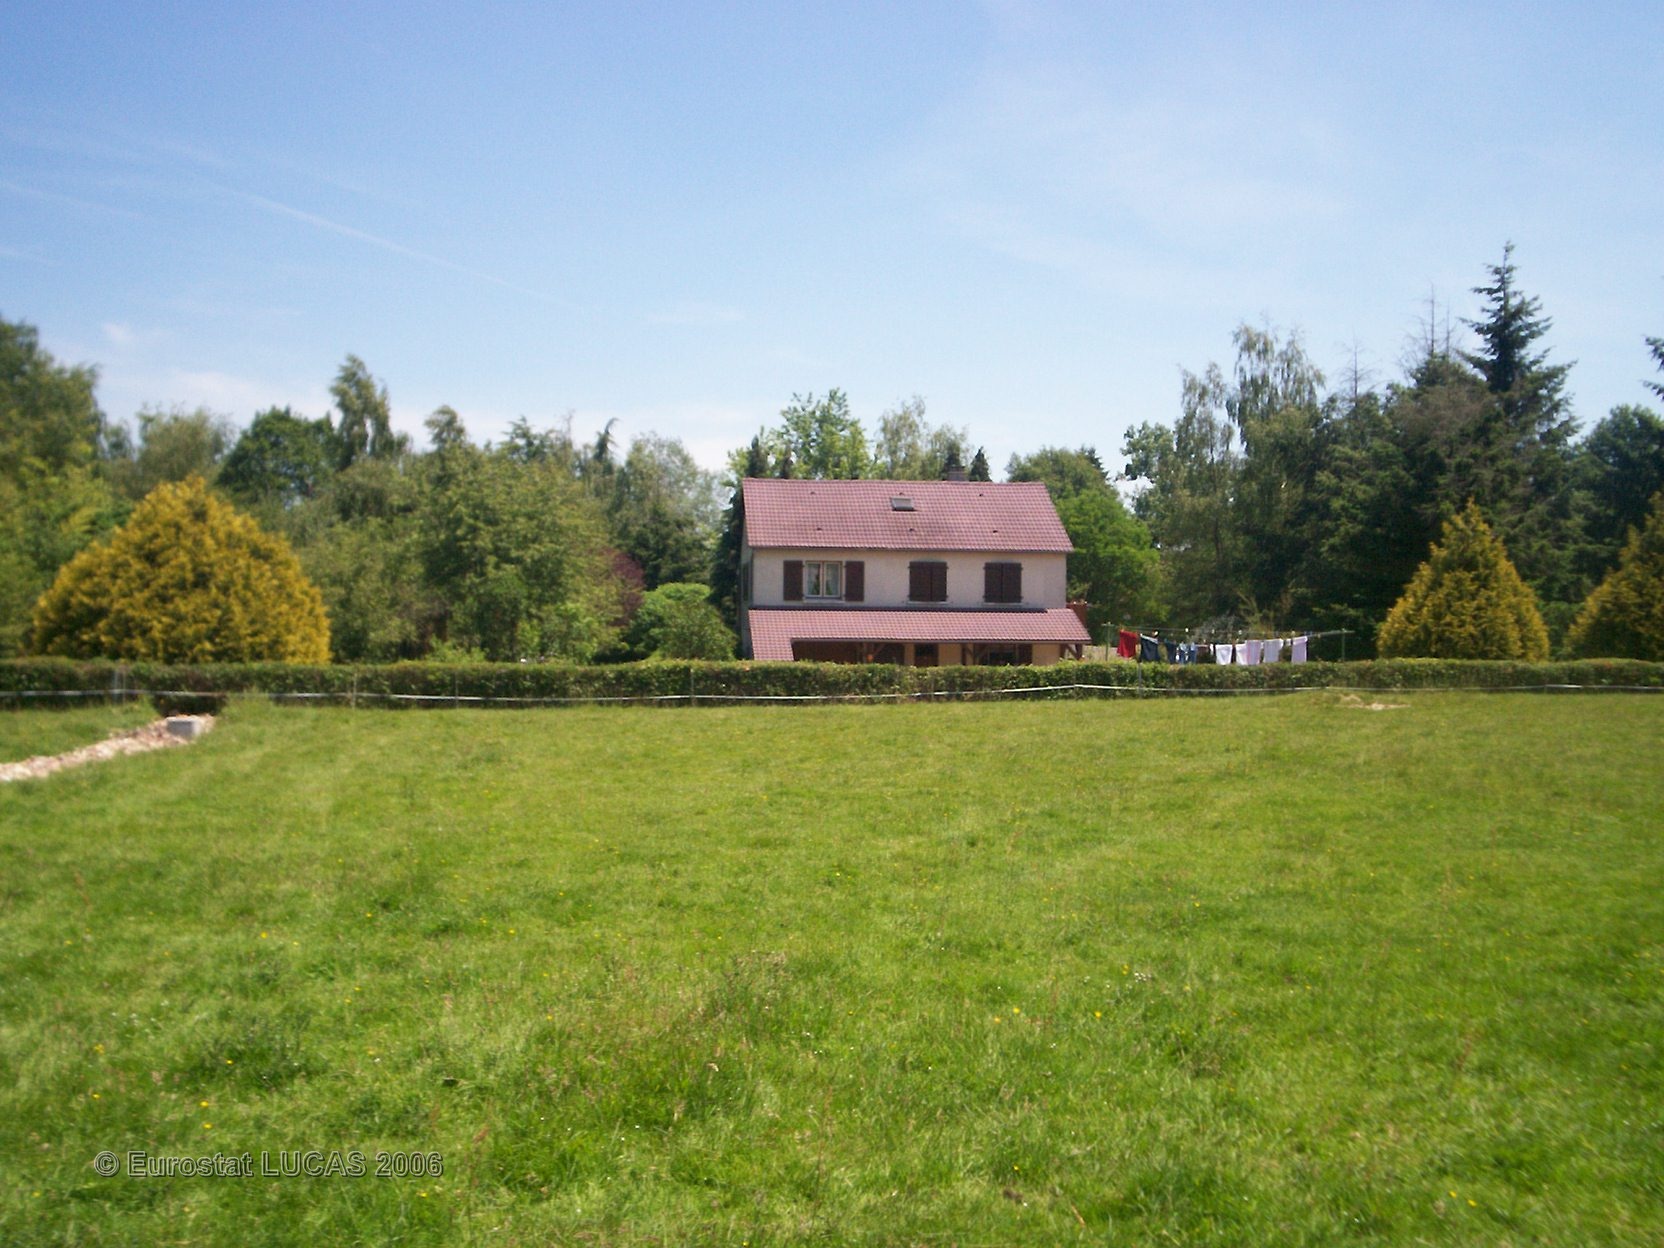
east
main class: Grassland
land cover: Grassland without tree/shrub cover
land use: Agriculture (excluding fallow land and kitchen gardens)
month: June
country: FR
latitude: 46.9526
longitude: 2.9924
